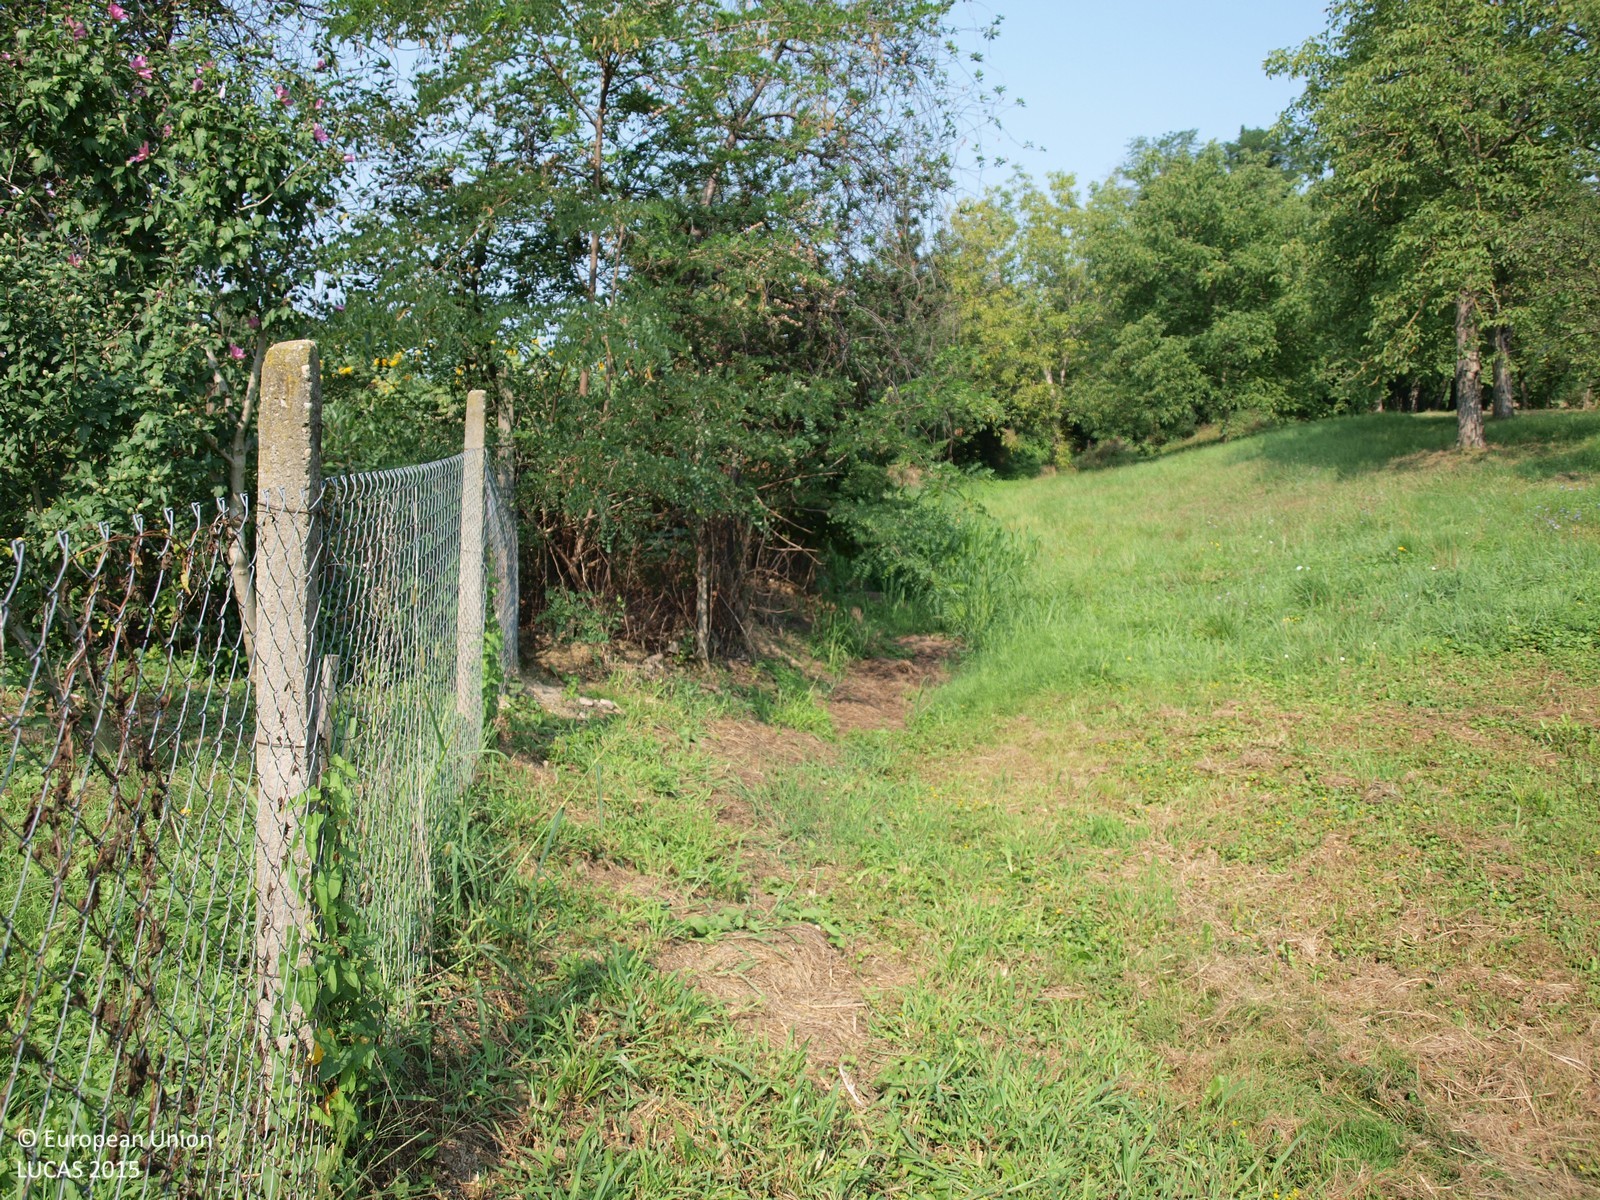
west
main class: Cropland
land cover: Tomatoes
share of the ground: > 75 %
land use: Kitchen garden
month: August
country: HR
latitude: 45.9046
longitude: 16.4315
